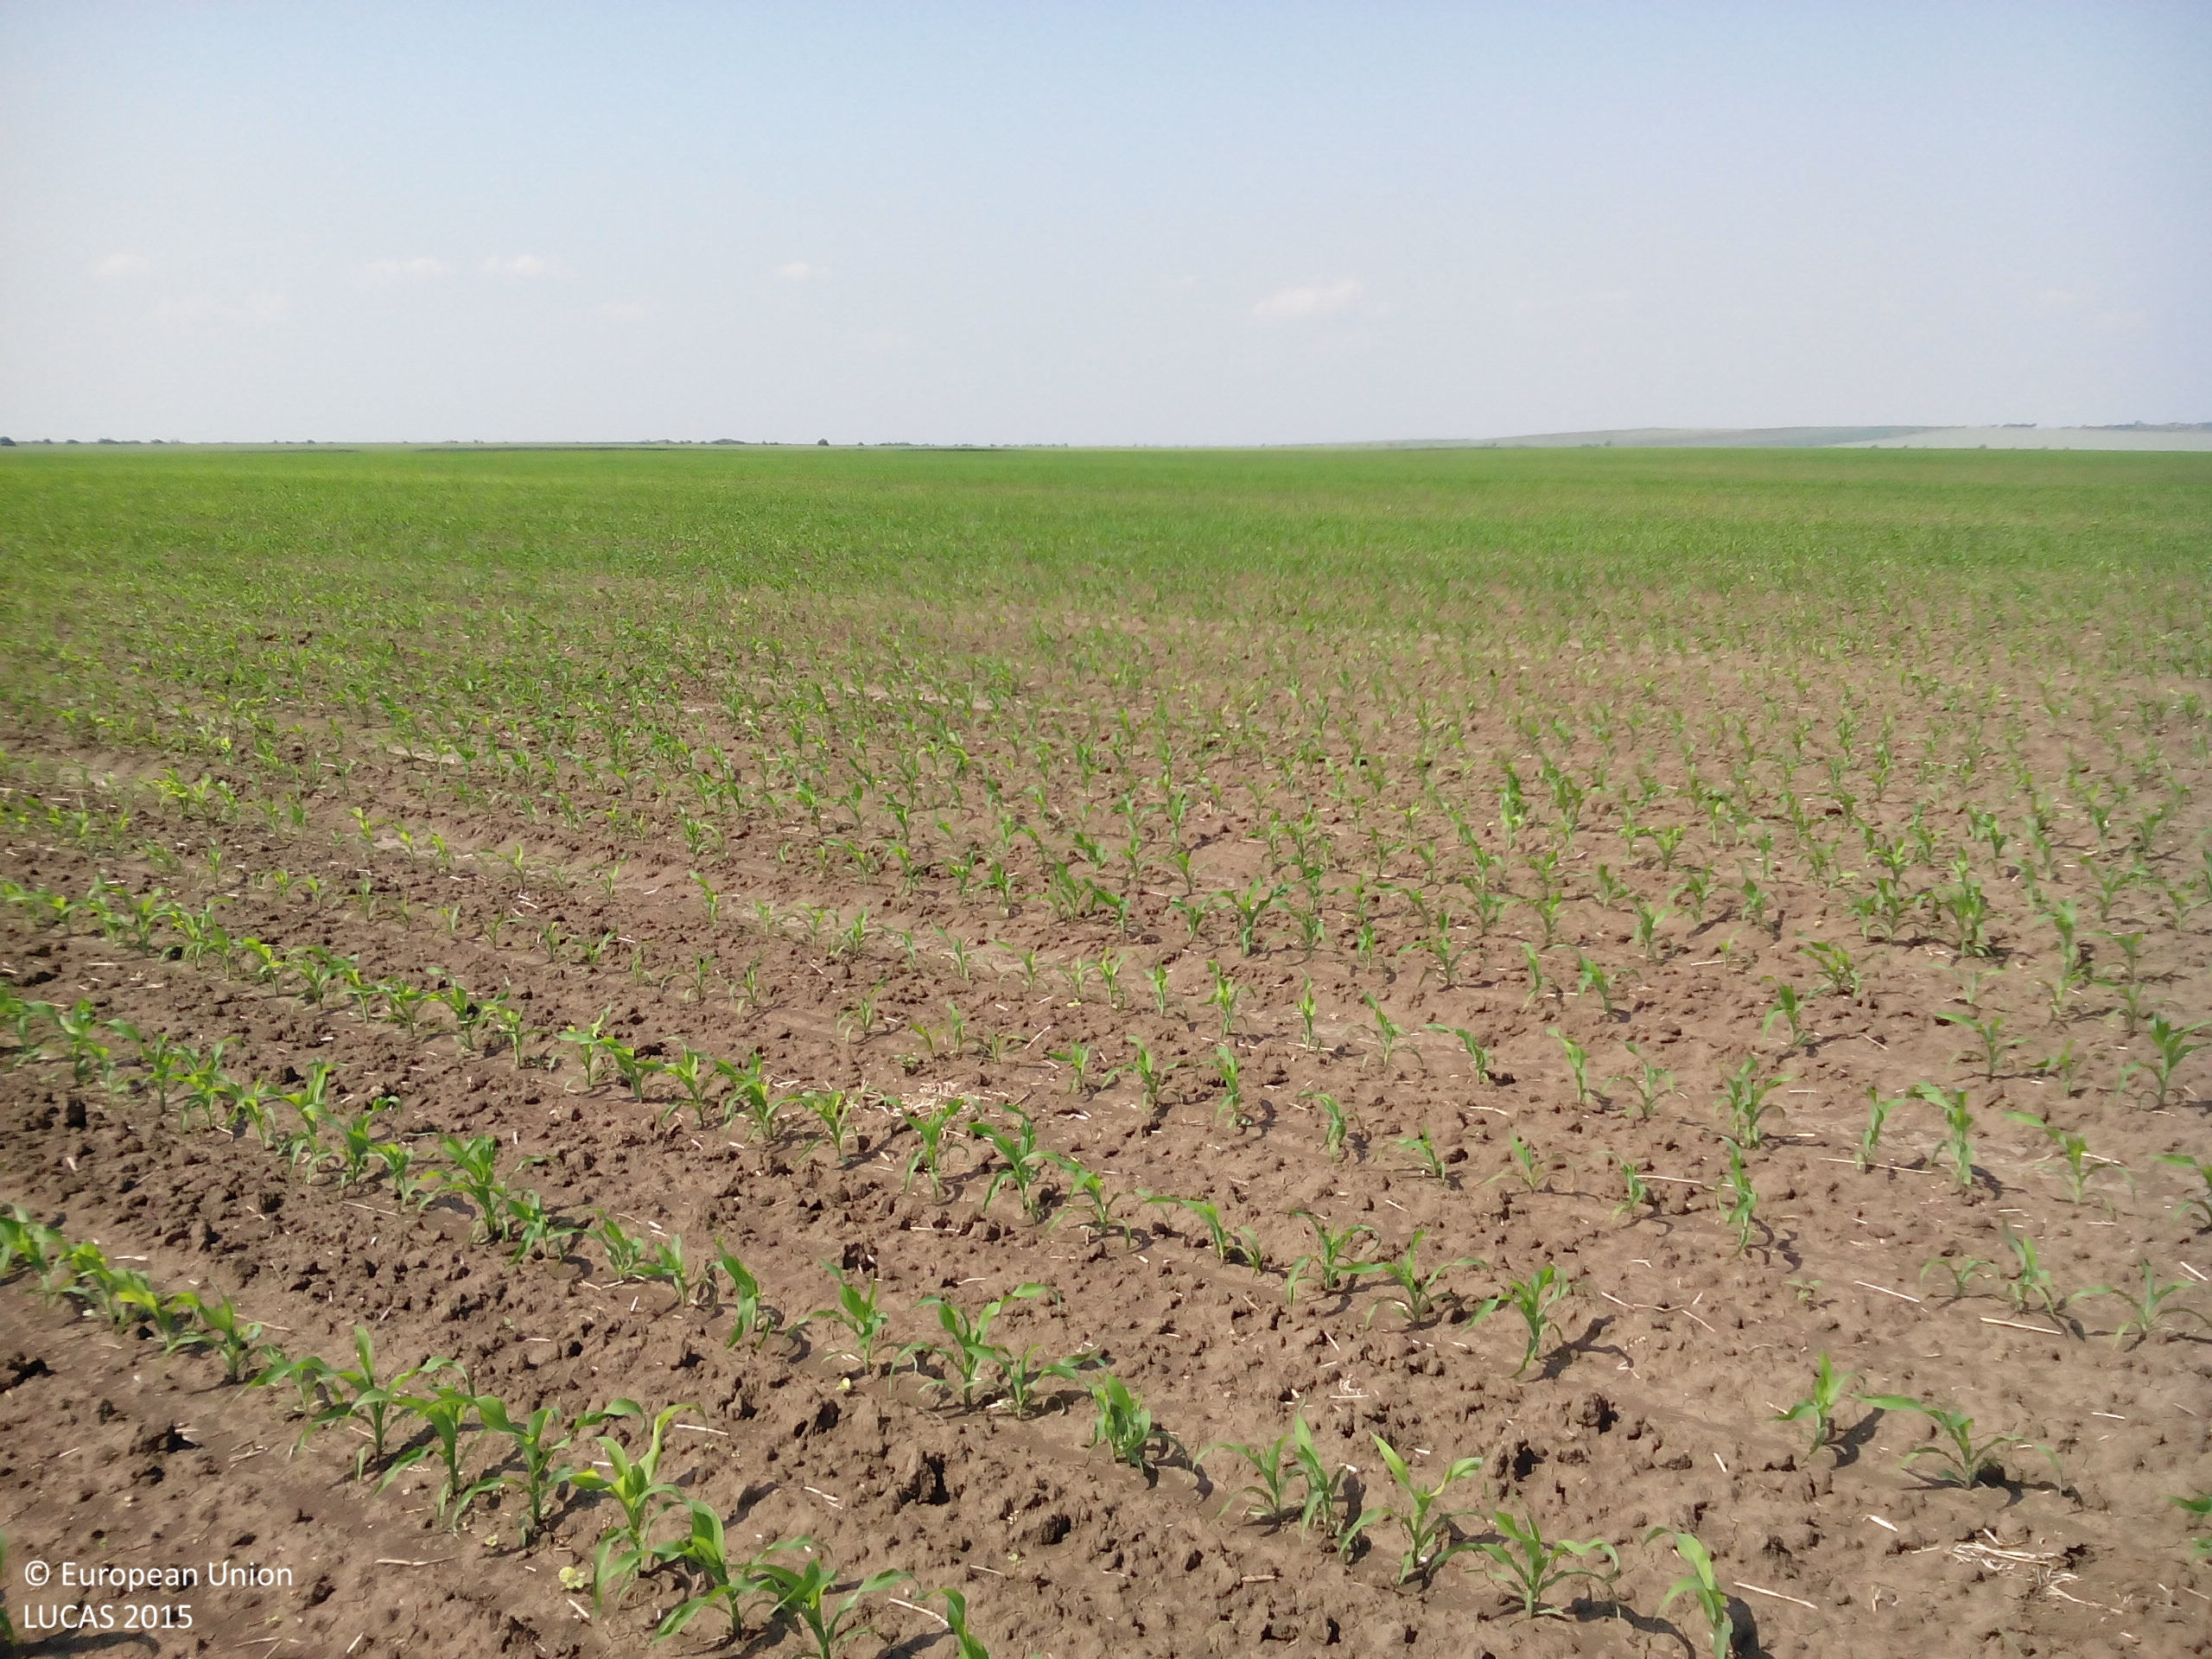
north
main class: Cropland
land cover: Maize
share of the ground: 10 - 25 %
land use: Agriculture (excluding fallow land and kitchen gardens)
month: May
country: BG
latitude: 43.6348
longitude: 24.1246
